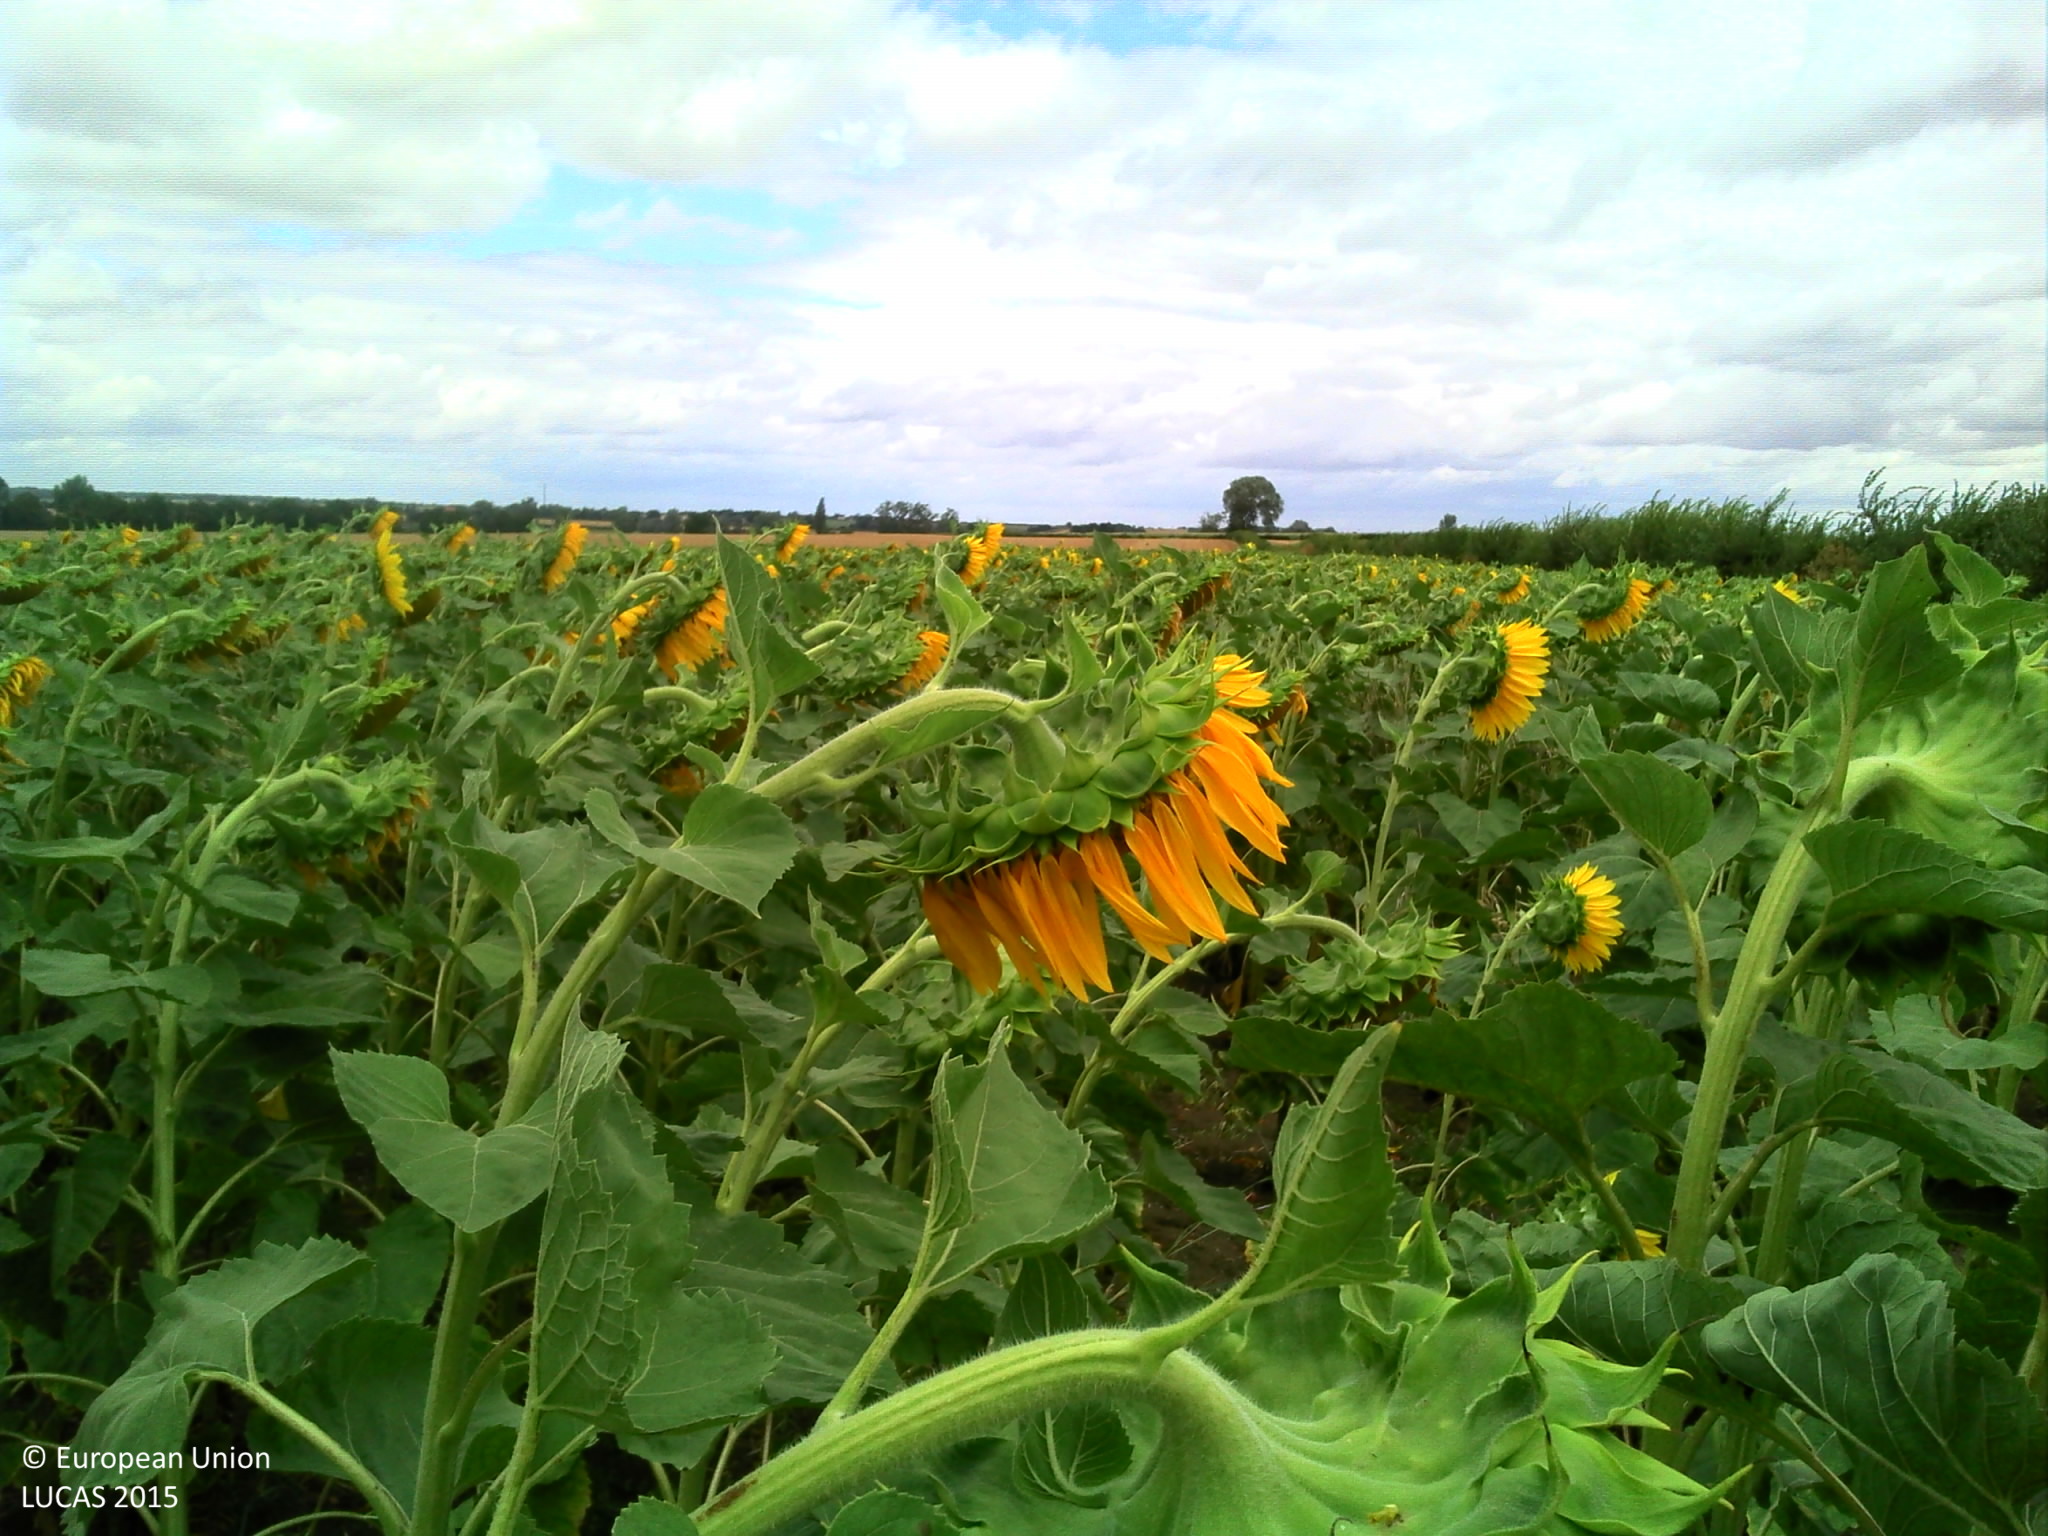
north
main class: Cropland
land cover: Sunflower
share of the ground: > 75 %
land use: Agriculture (excluding fallow land and kitchen gardens)
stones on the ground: < 10 %
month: July
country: FR
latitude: 46.7952
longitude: 2.2764
